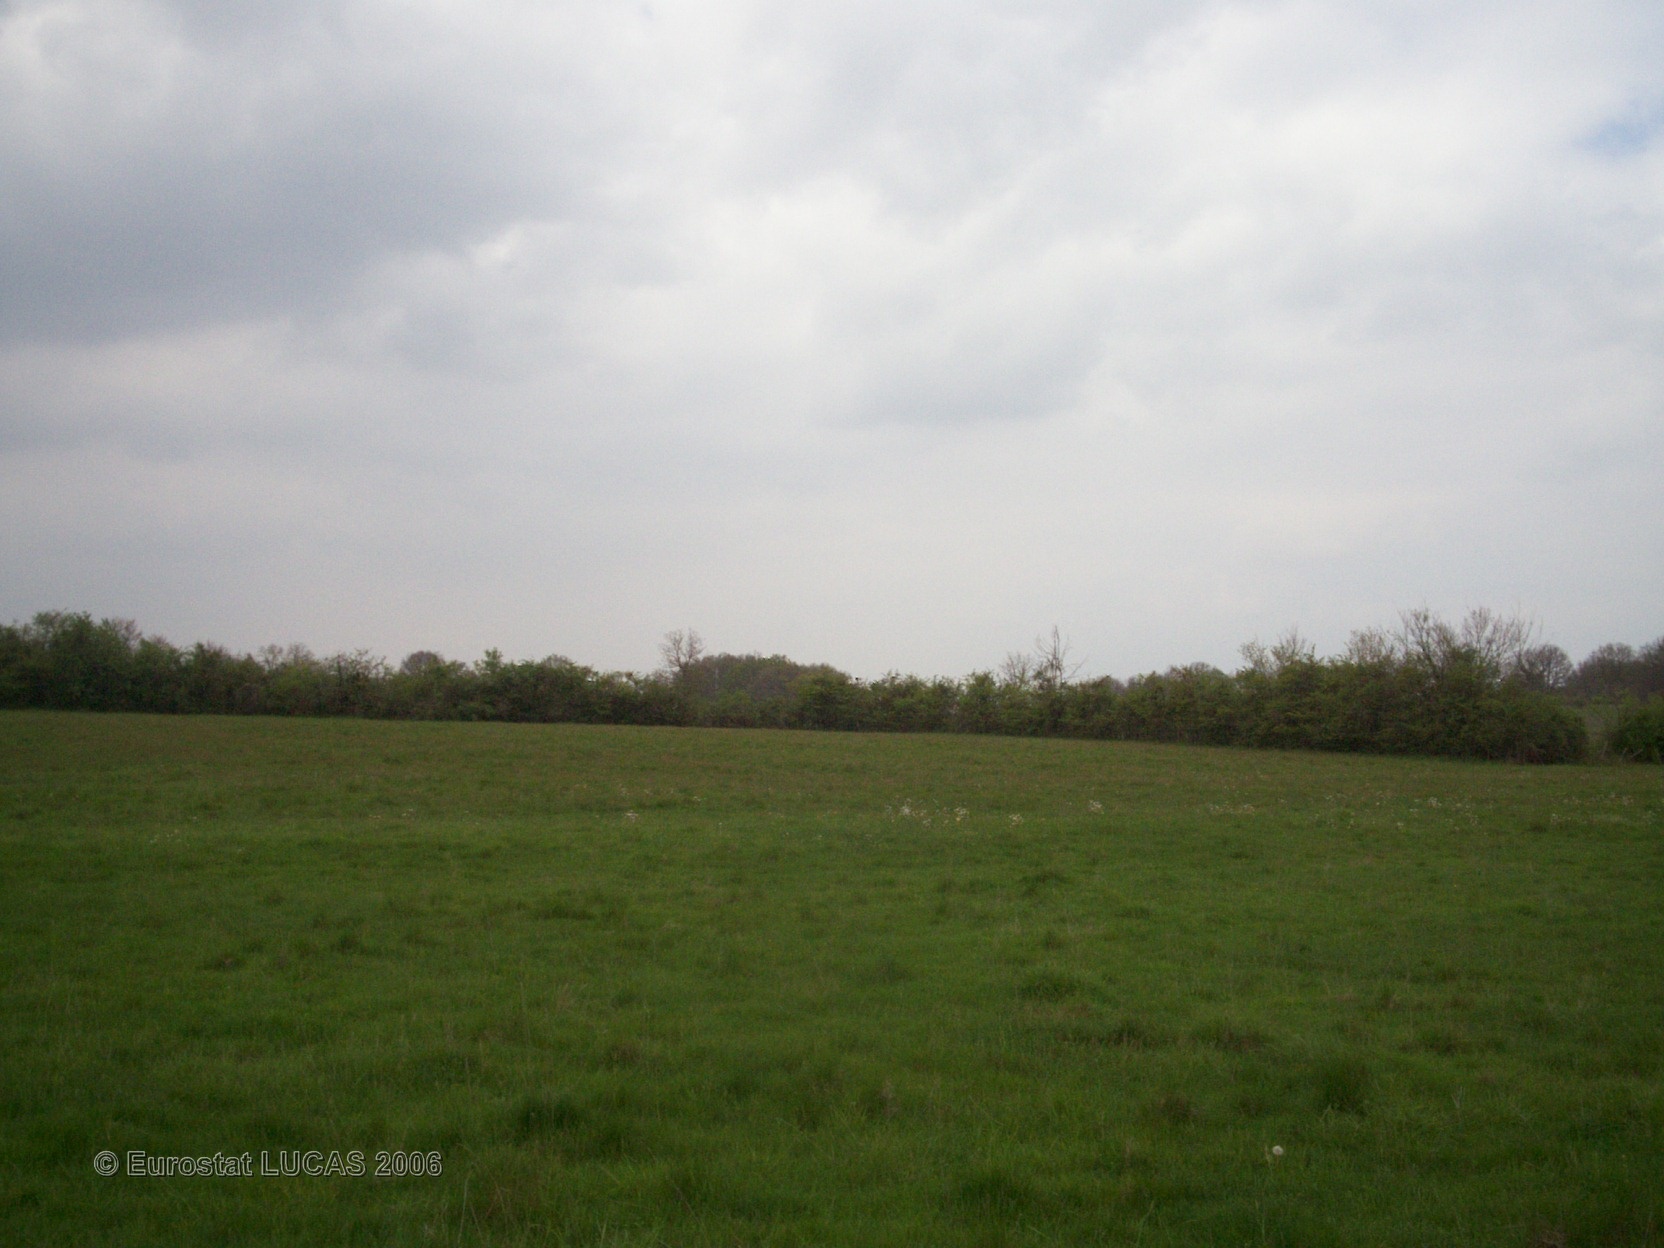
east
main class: Grassland
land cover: Grassland without tree/shrub cover
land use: Agriculture (excluding fallow land and kitchen gardens)
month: April
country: FR
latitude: 46.4796
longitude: 0.5921
